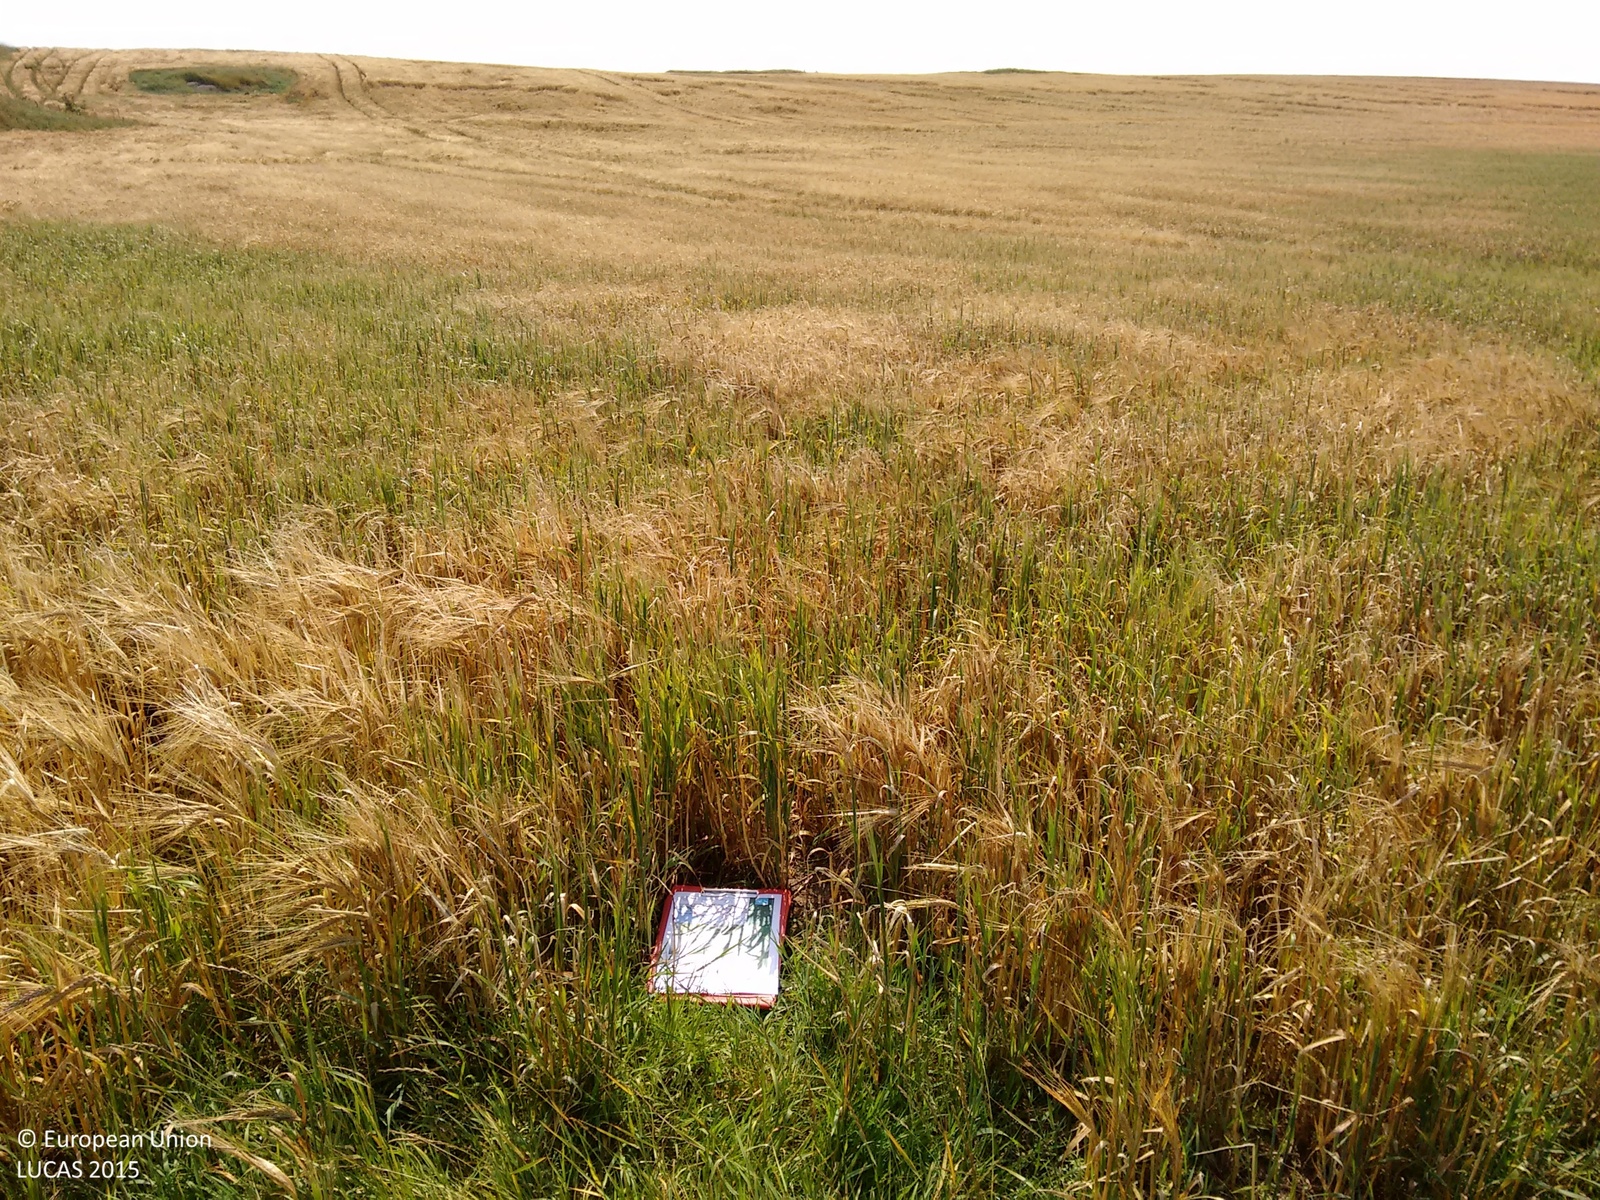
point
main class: Cropland
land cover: Barley
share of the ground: > 75 %
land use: Agriculture (excluding fallow land and kitchen gardens)
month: August
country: GB
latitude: 53.2179
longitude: -4.4970
